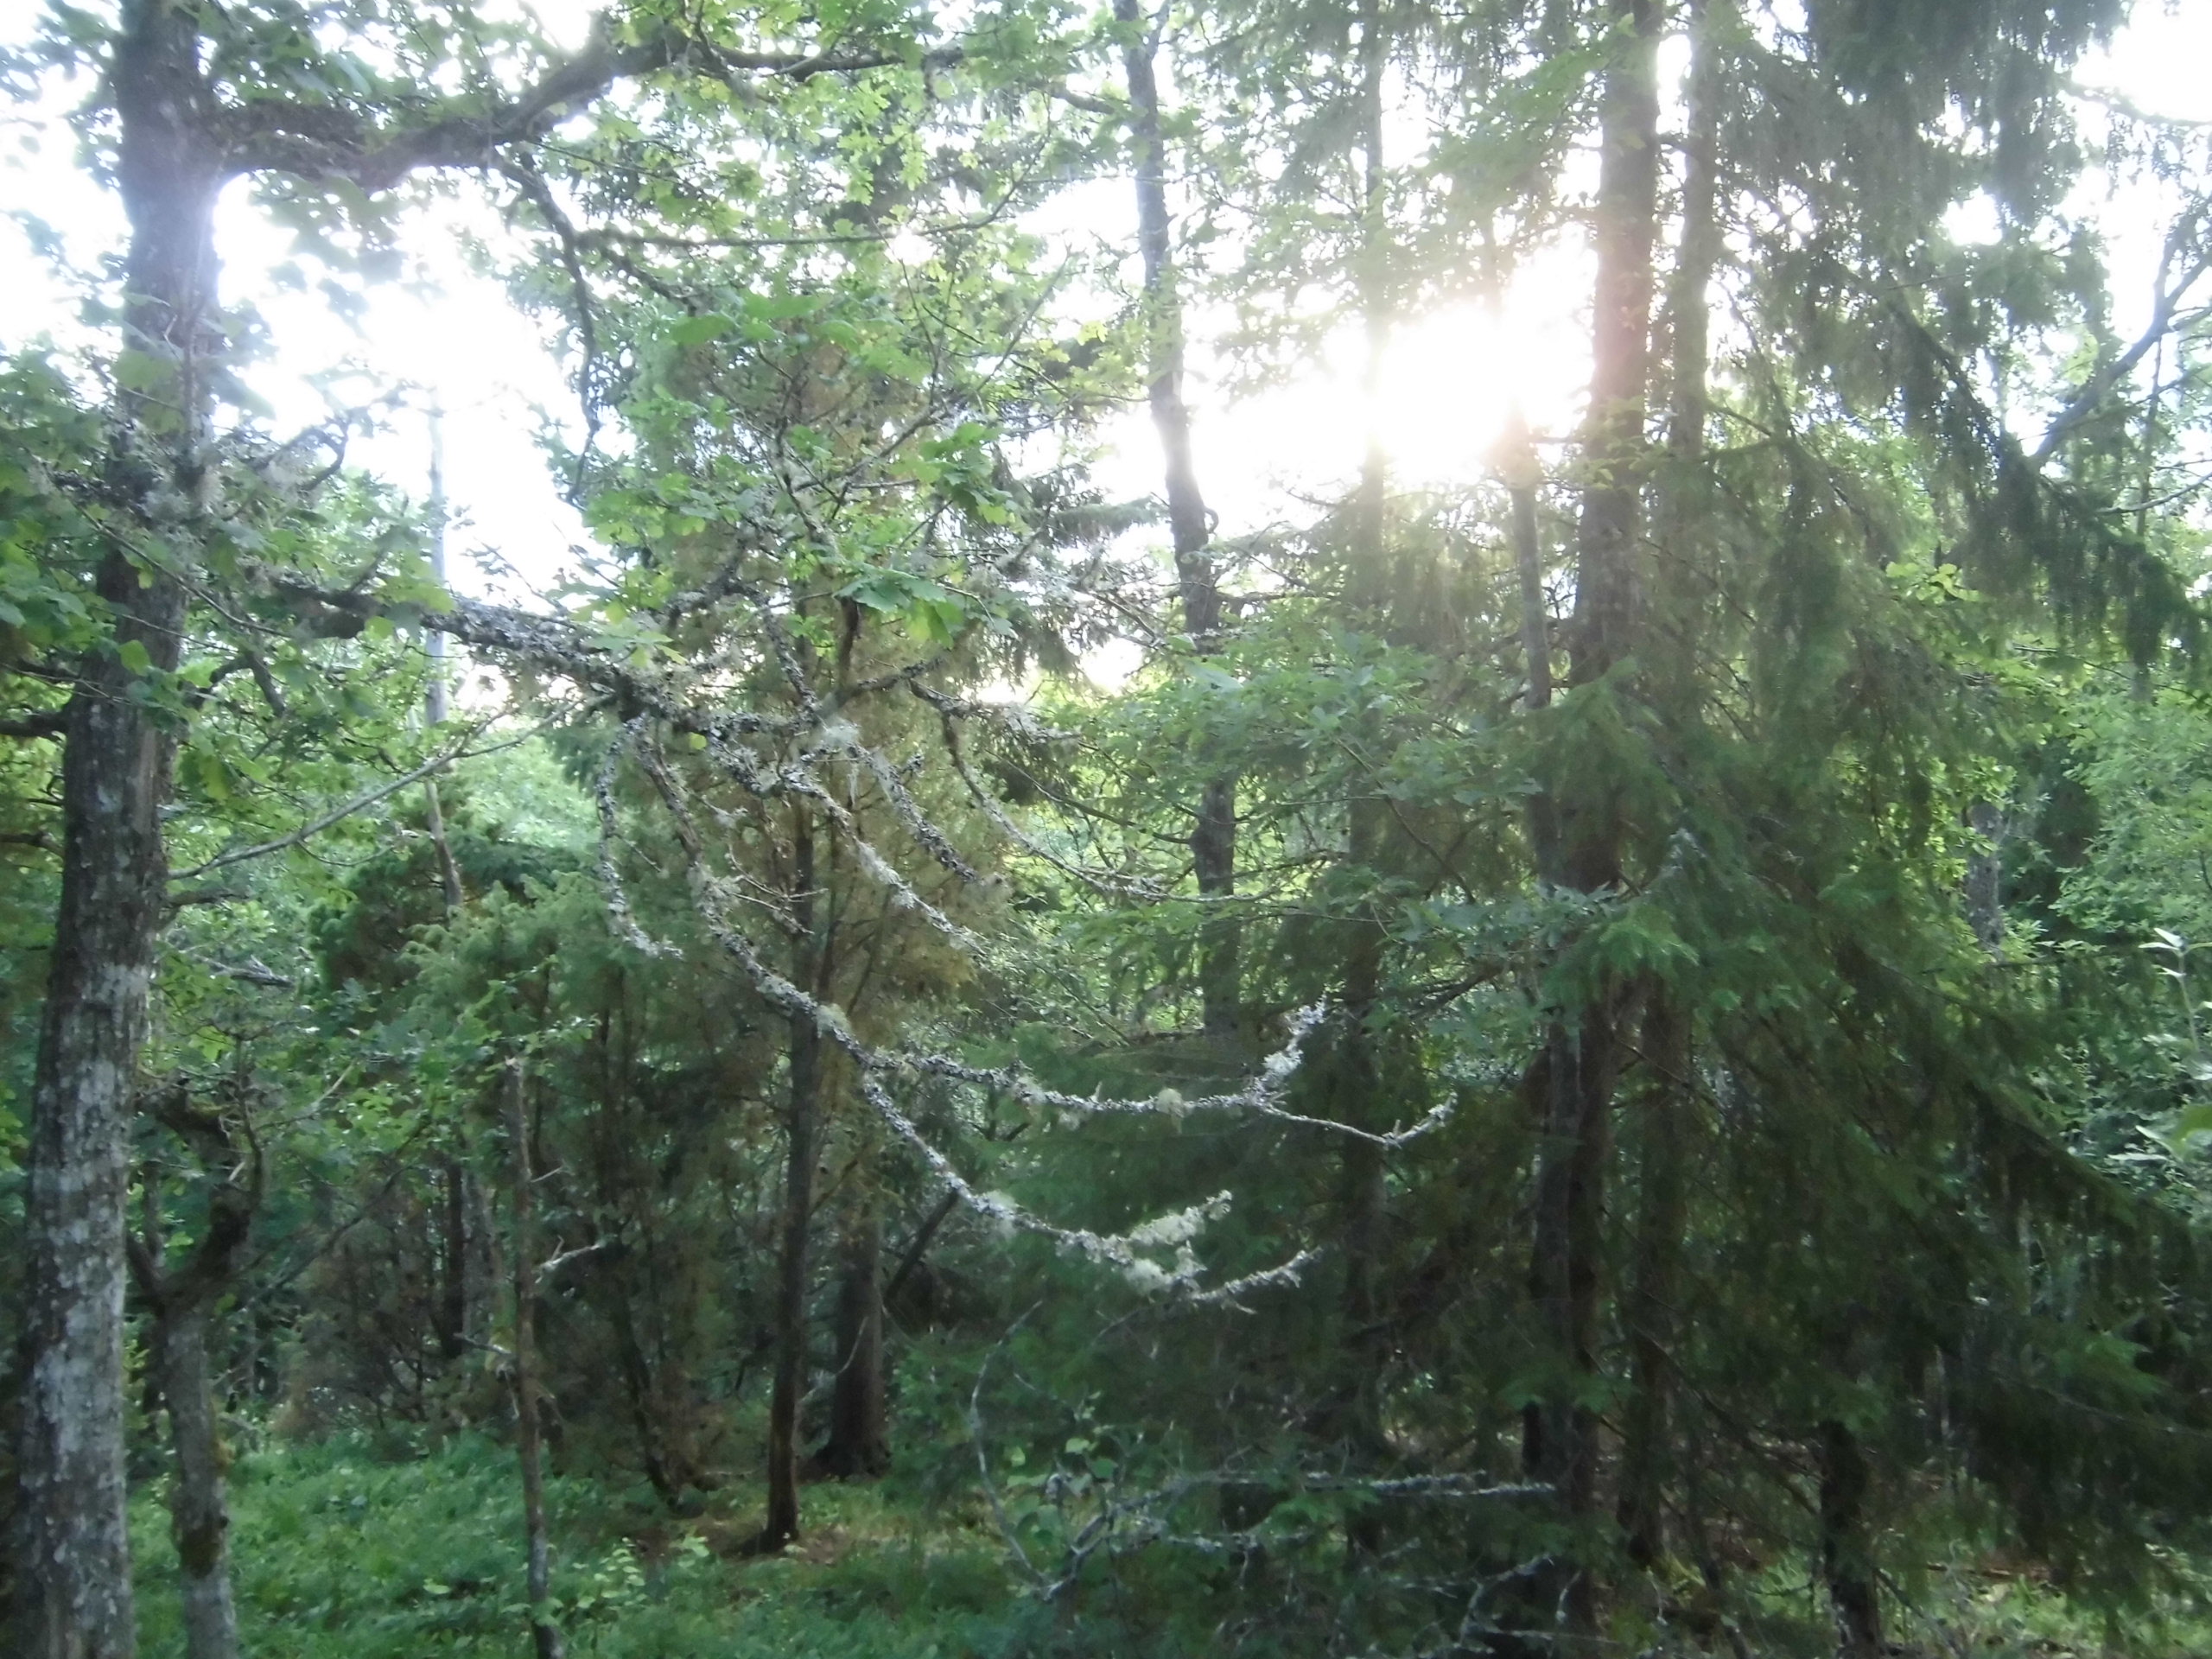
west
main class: Woodland
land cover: Spruce dominated mixed woodland
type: boreal forest
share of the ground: 50 - 75 %
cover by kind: coniferous forest trees 30 %, shrubs 25 %, broadleaved forest trees 20 %, herbaceous plants 15 %, lichens and mosses 10 %
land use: Forestry
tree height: > 5 m
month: July
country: SE
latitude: 57.3772
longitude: 15.2689
